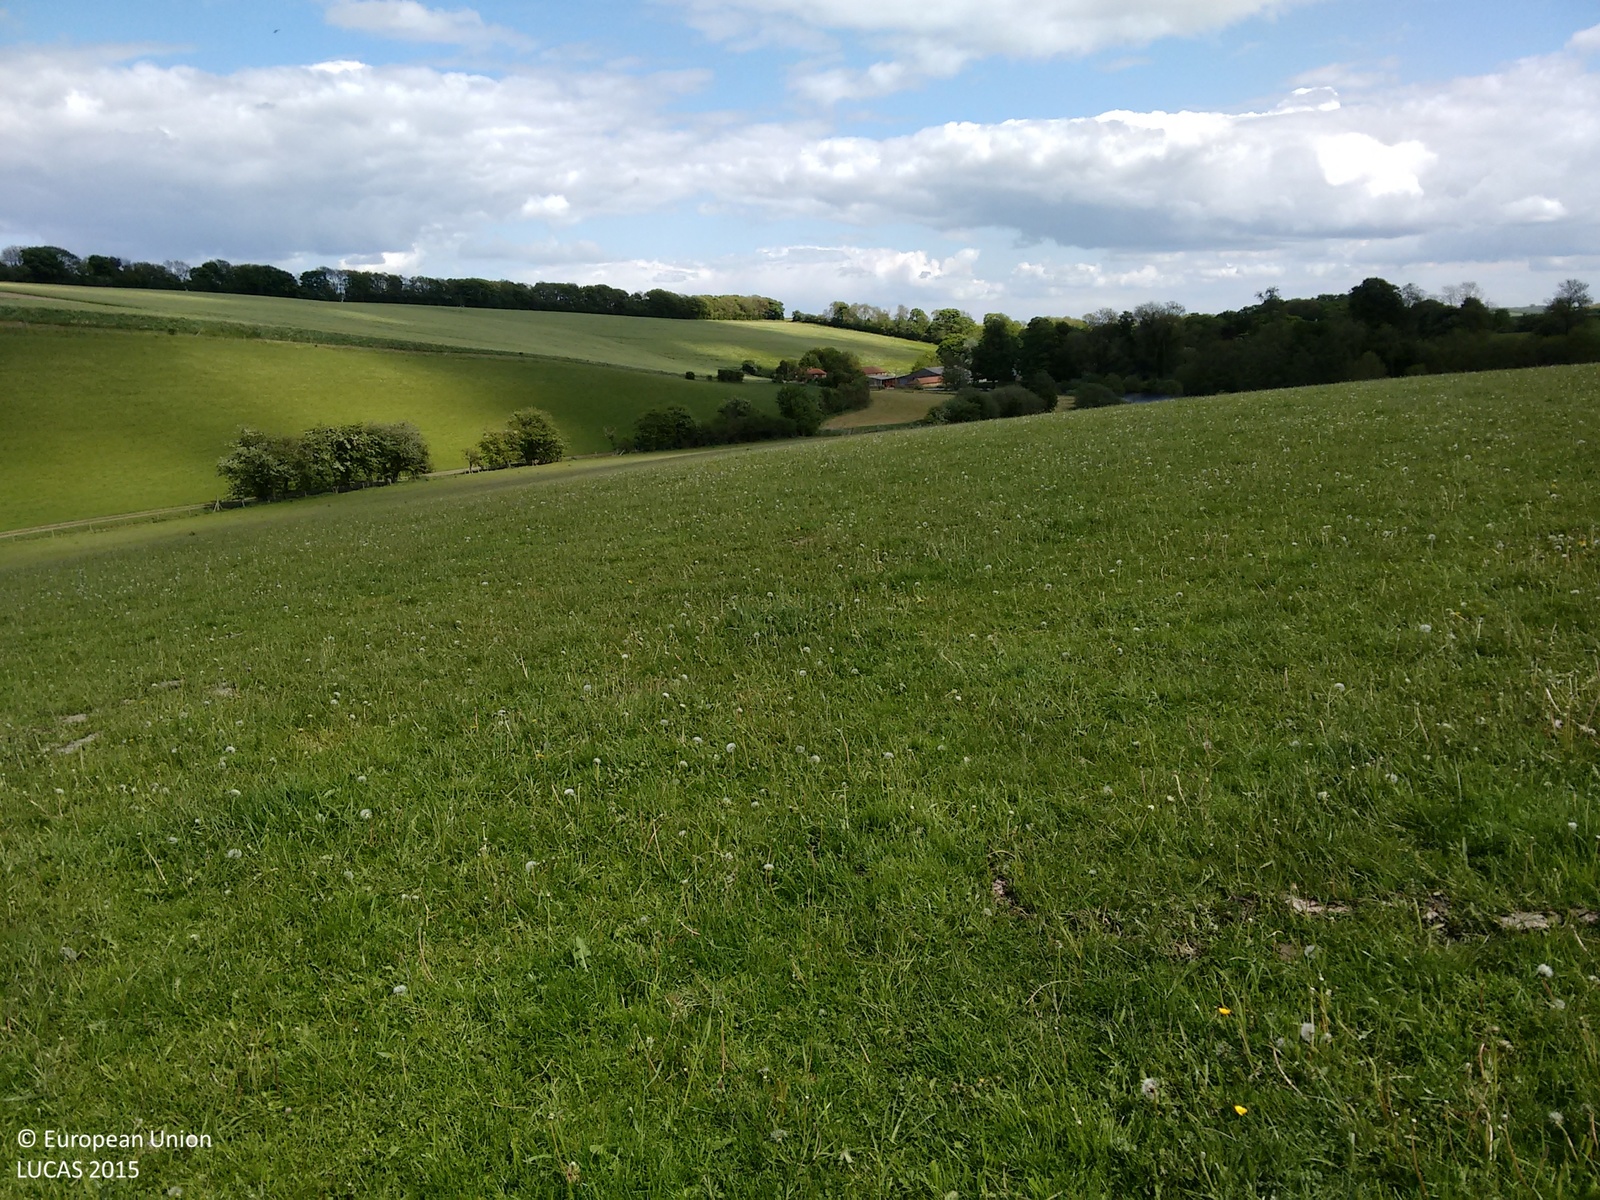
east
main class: Grassland
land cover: Grassland without tree/shrub cover
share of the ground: > 75 %
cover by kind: herbaceous plants 100 %
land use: Agriculture (excluding fallow land and kitchen gardens)
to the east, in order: Grassland without tree/shrub cover; Ditches and canals; Fences; Abandoned hedges
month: May
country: GB
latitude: 53.4367
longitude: -0.2555
